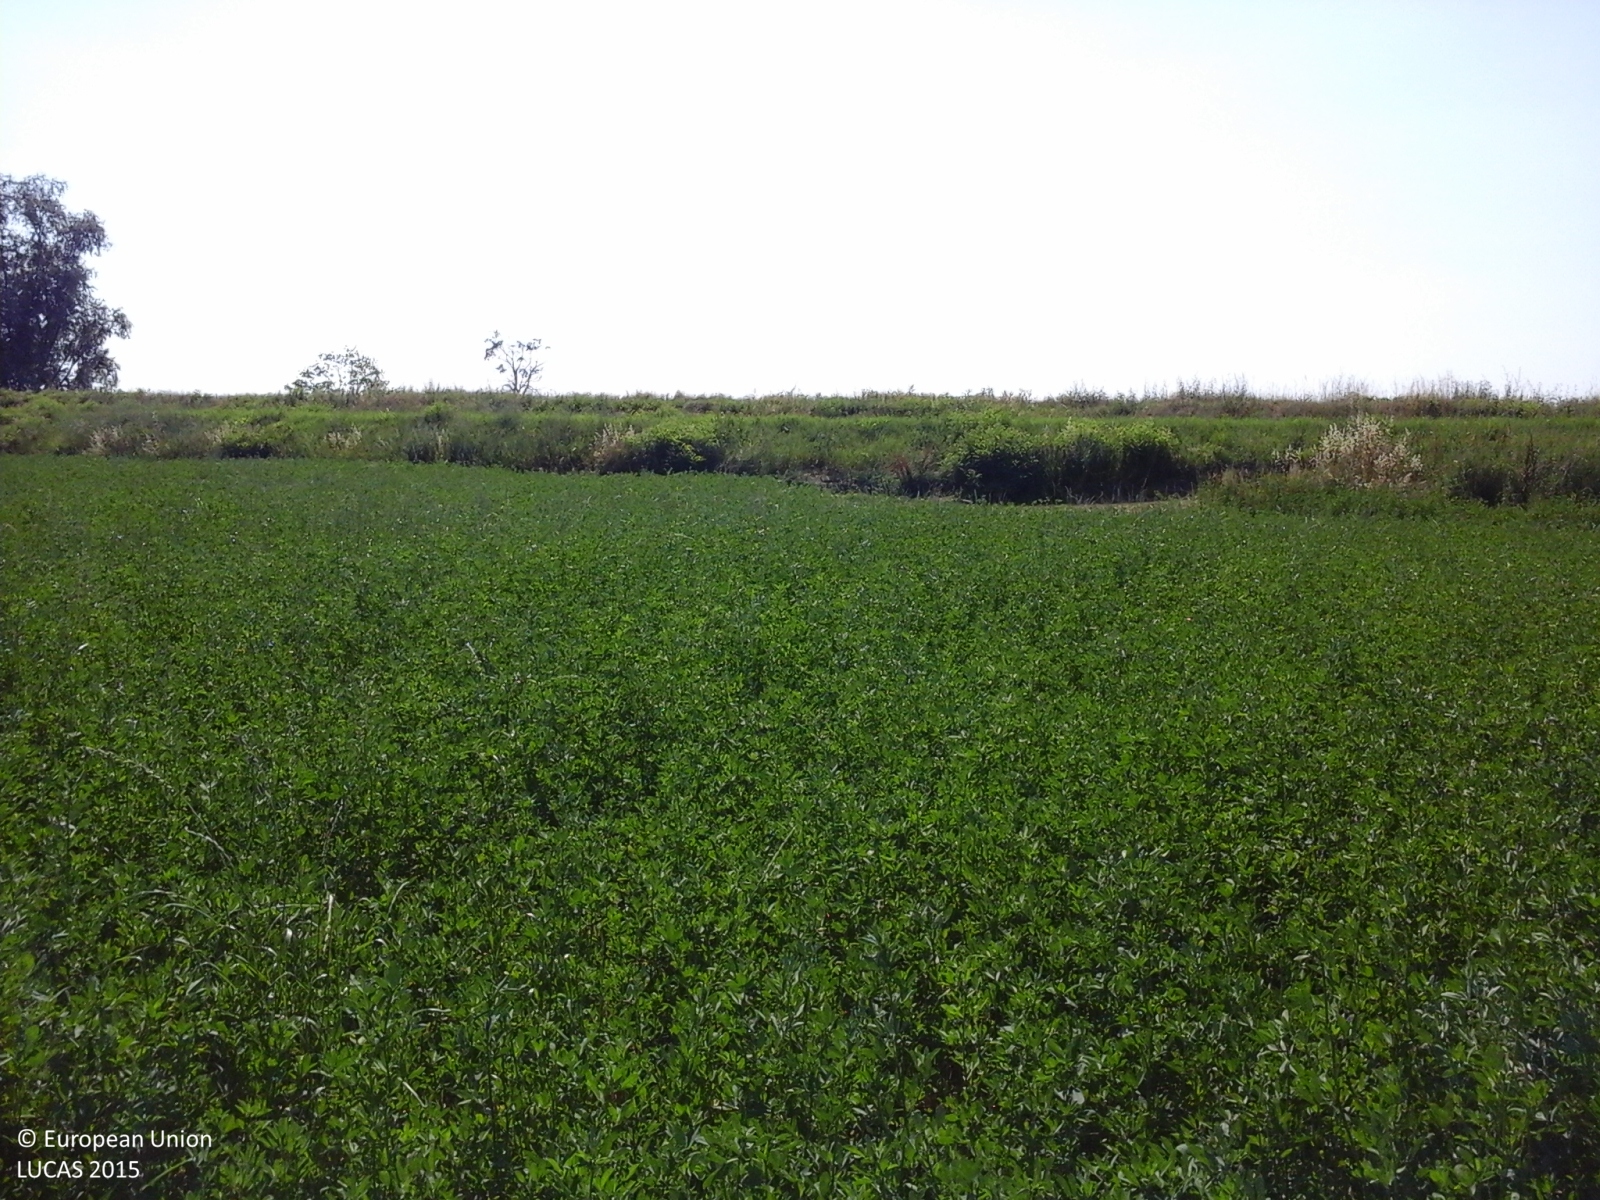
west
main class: Cropland
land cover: Lucerne
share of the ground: > 75 %
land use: Agriculture (excluding fallow land and kitchen gardens)
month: June
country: IT
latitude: 44.9454
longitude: 10.2150
